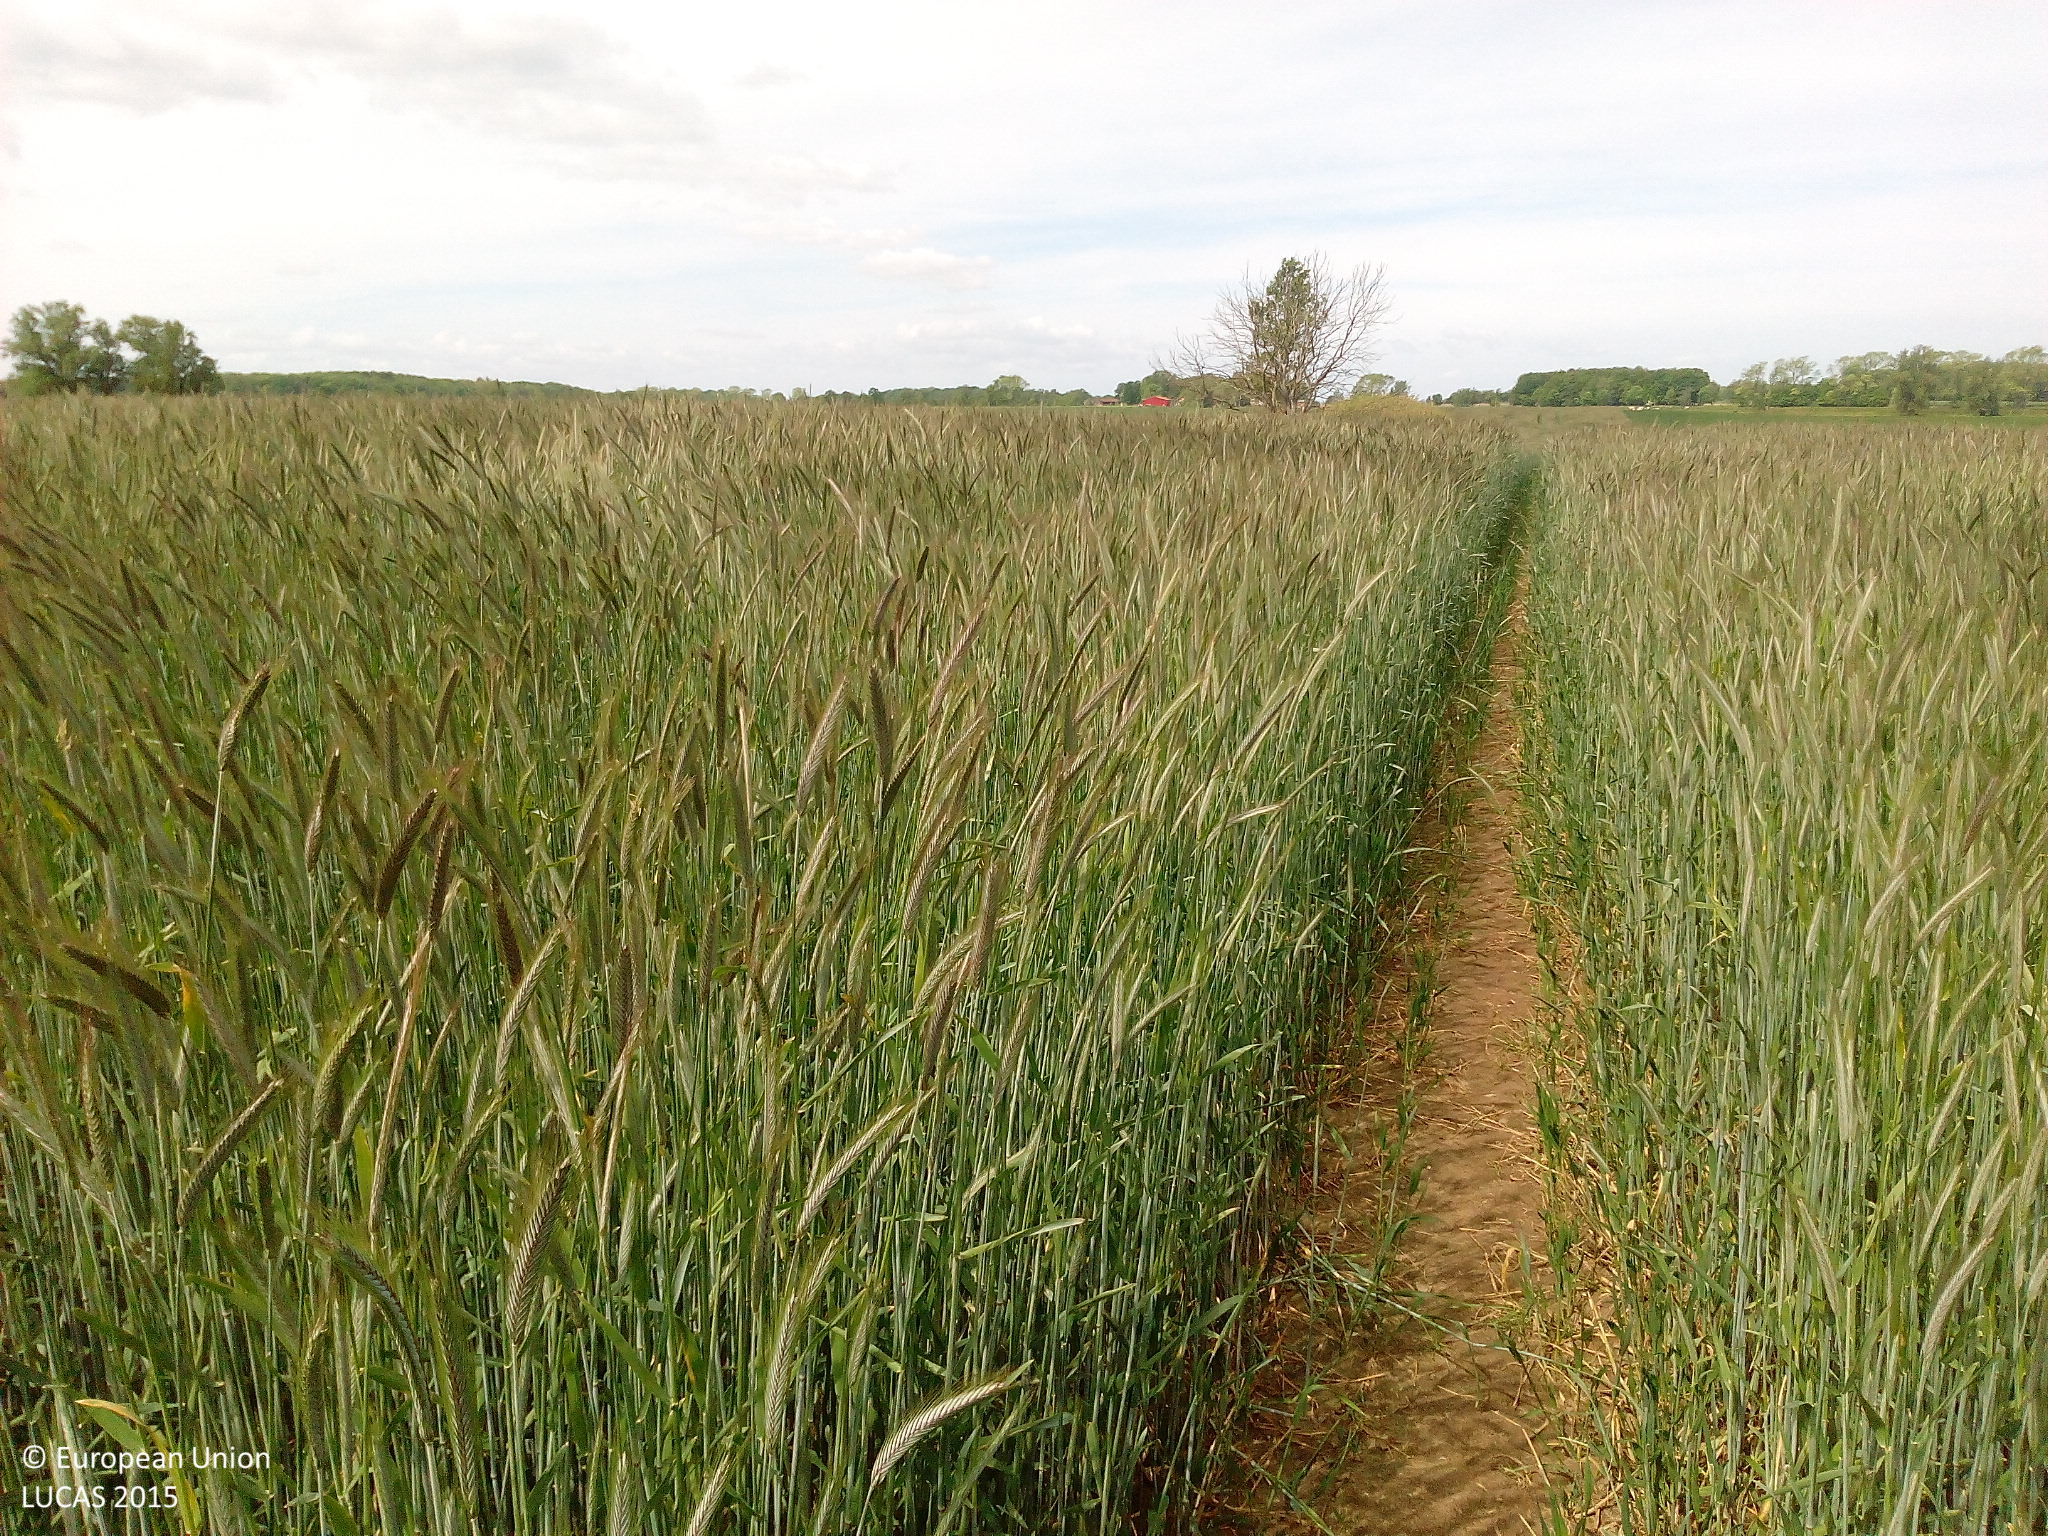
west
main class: Cropland
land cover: Rye
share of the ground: > 75 %
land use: Agriculture (excluding fallow land and kitchen gardens)
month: June
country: DE
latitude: 54.4009
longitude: 13.2802
